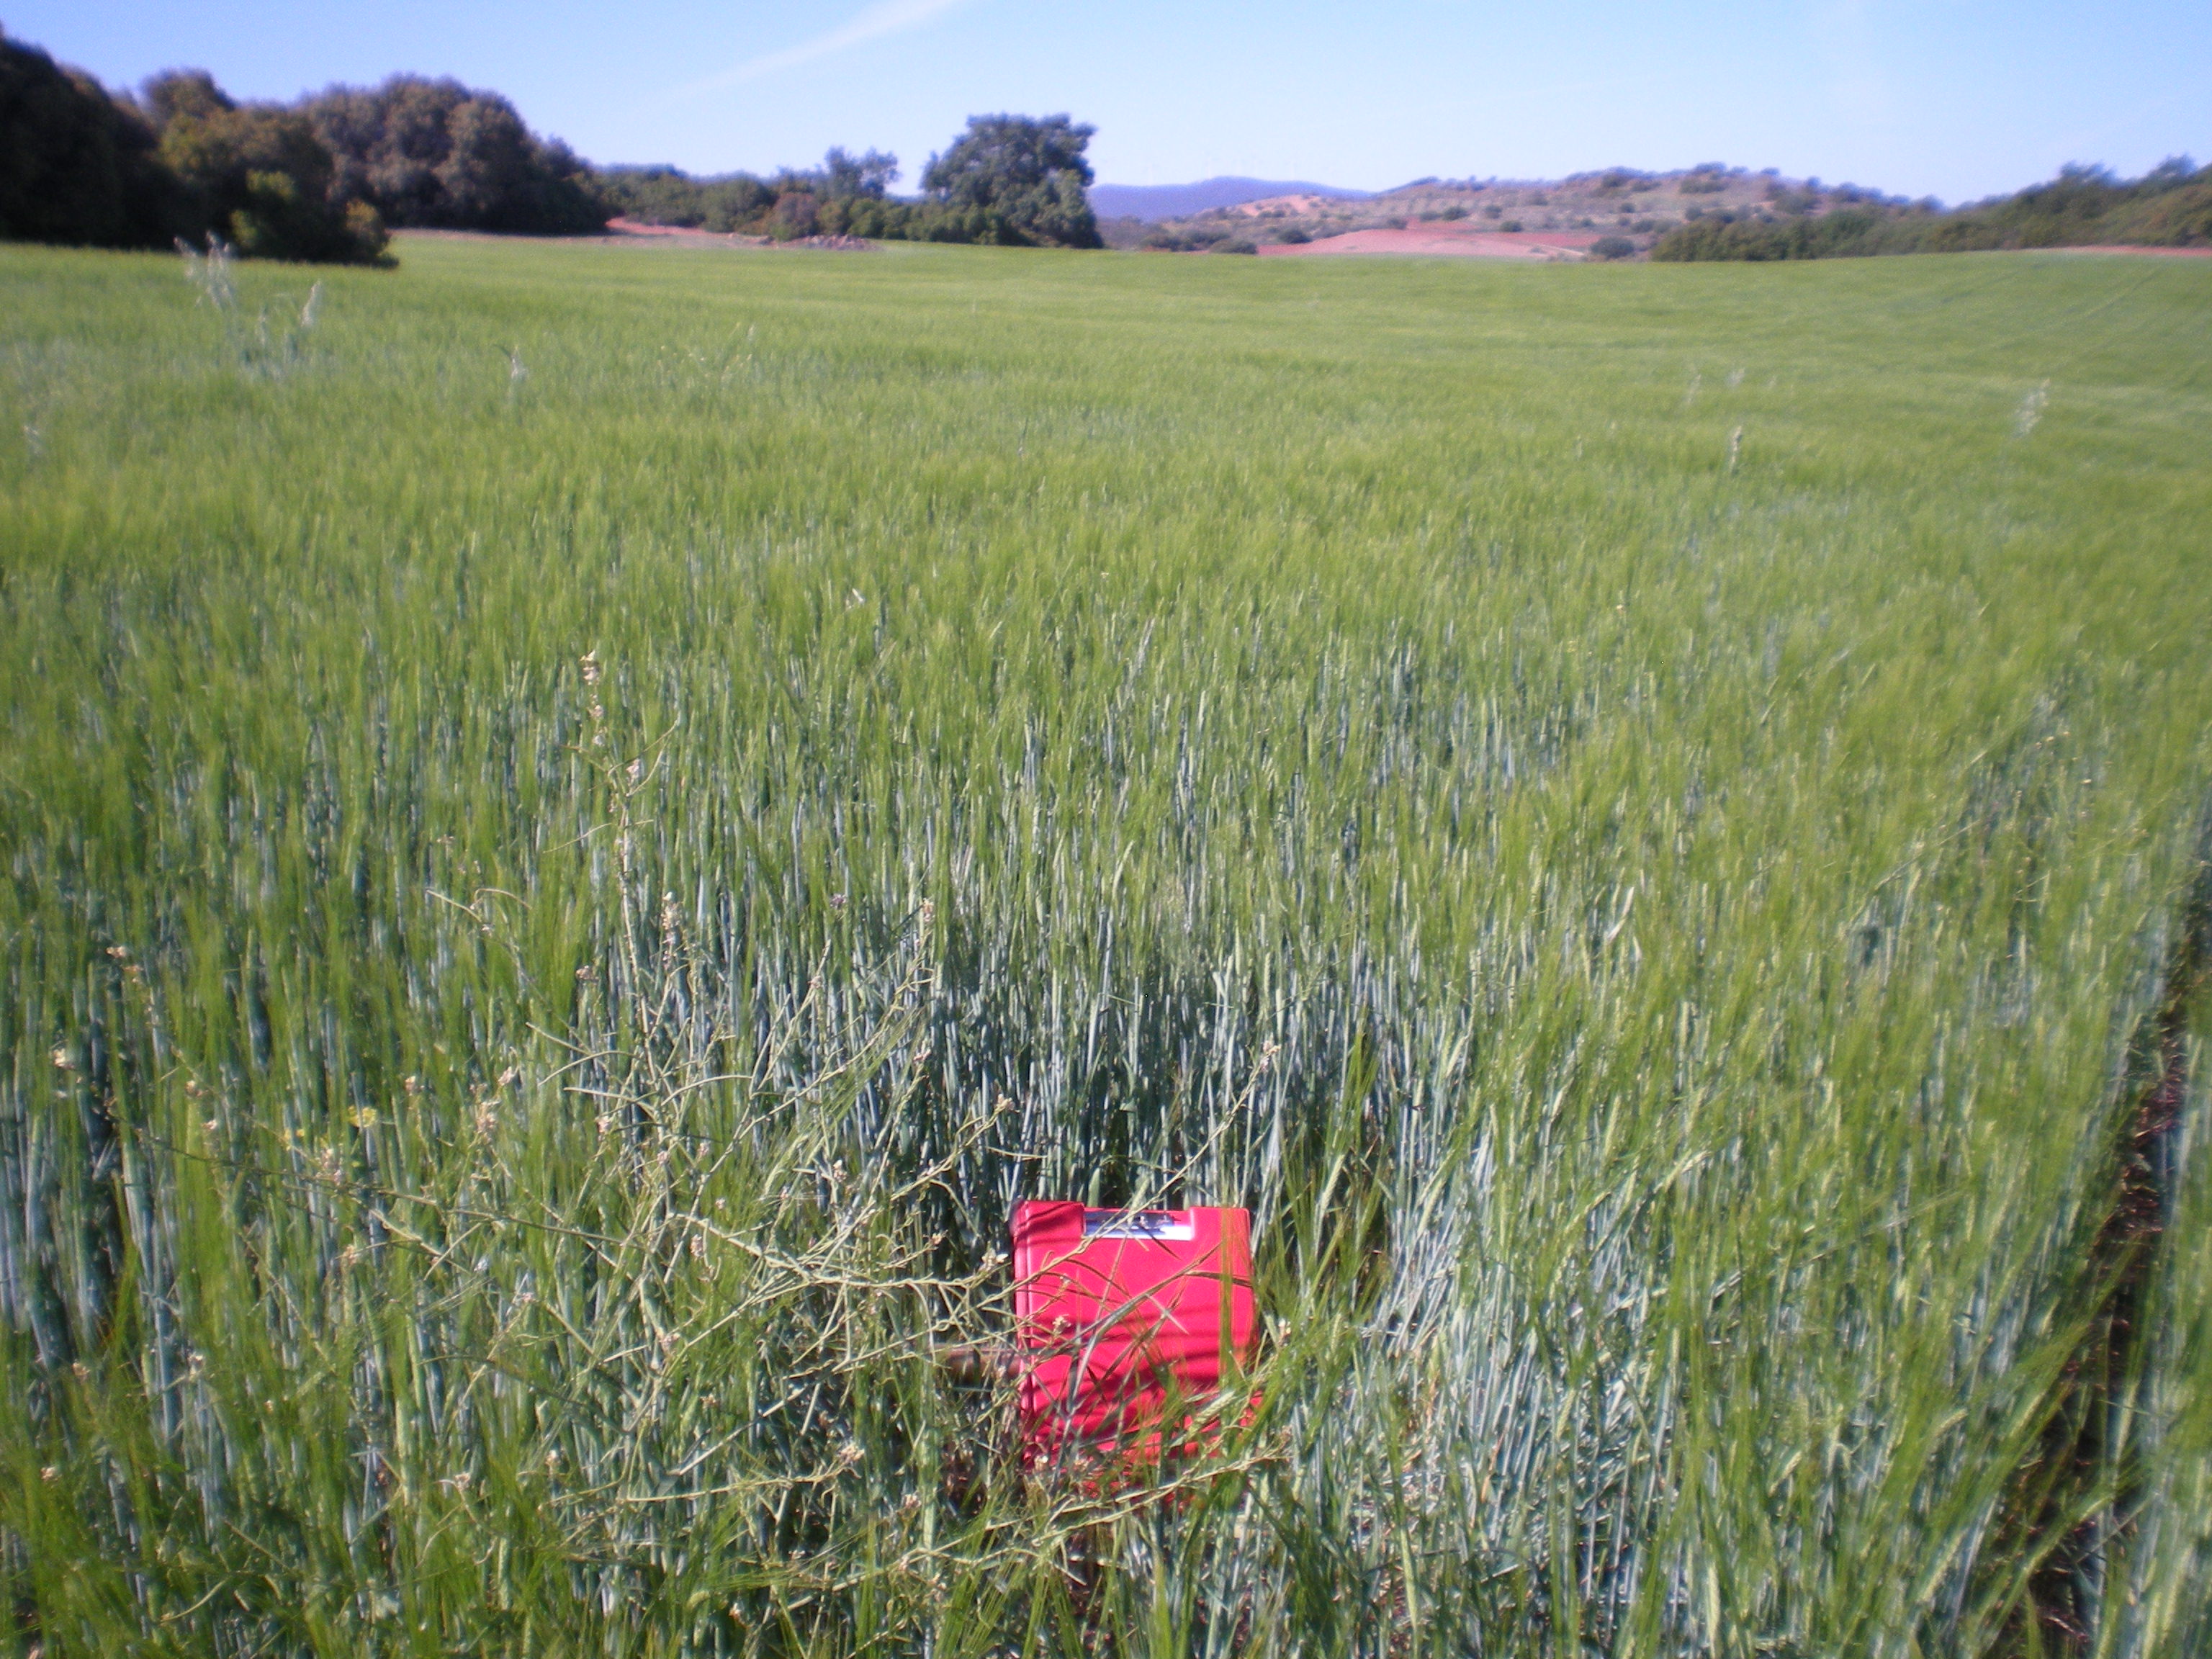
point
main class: Cropland
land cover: Barley
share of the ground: > 75 %
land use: Agriculture (excluding fallow land and kitchen gardens)
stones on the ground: 10 - 25 %
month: May
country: ES
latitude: 38.9360
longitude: -3.0343
